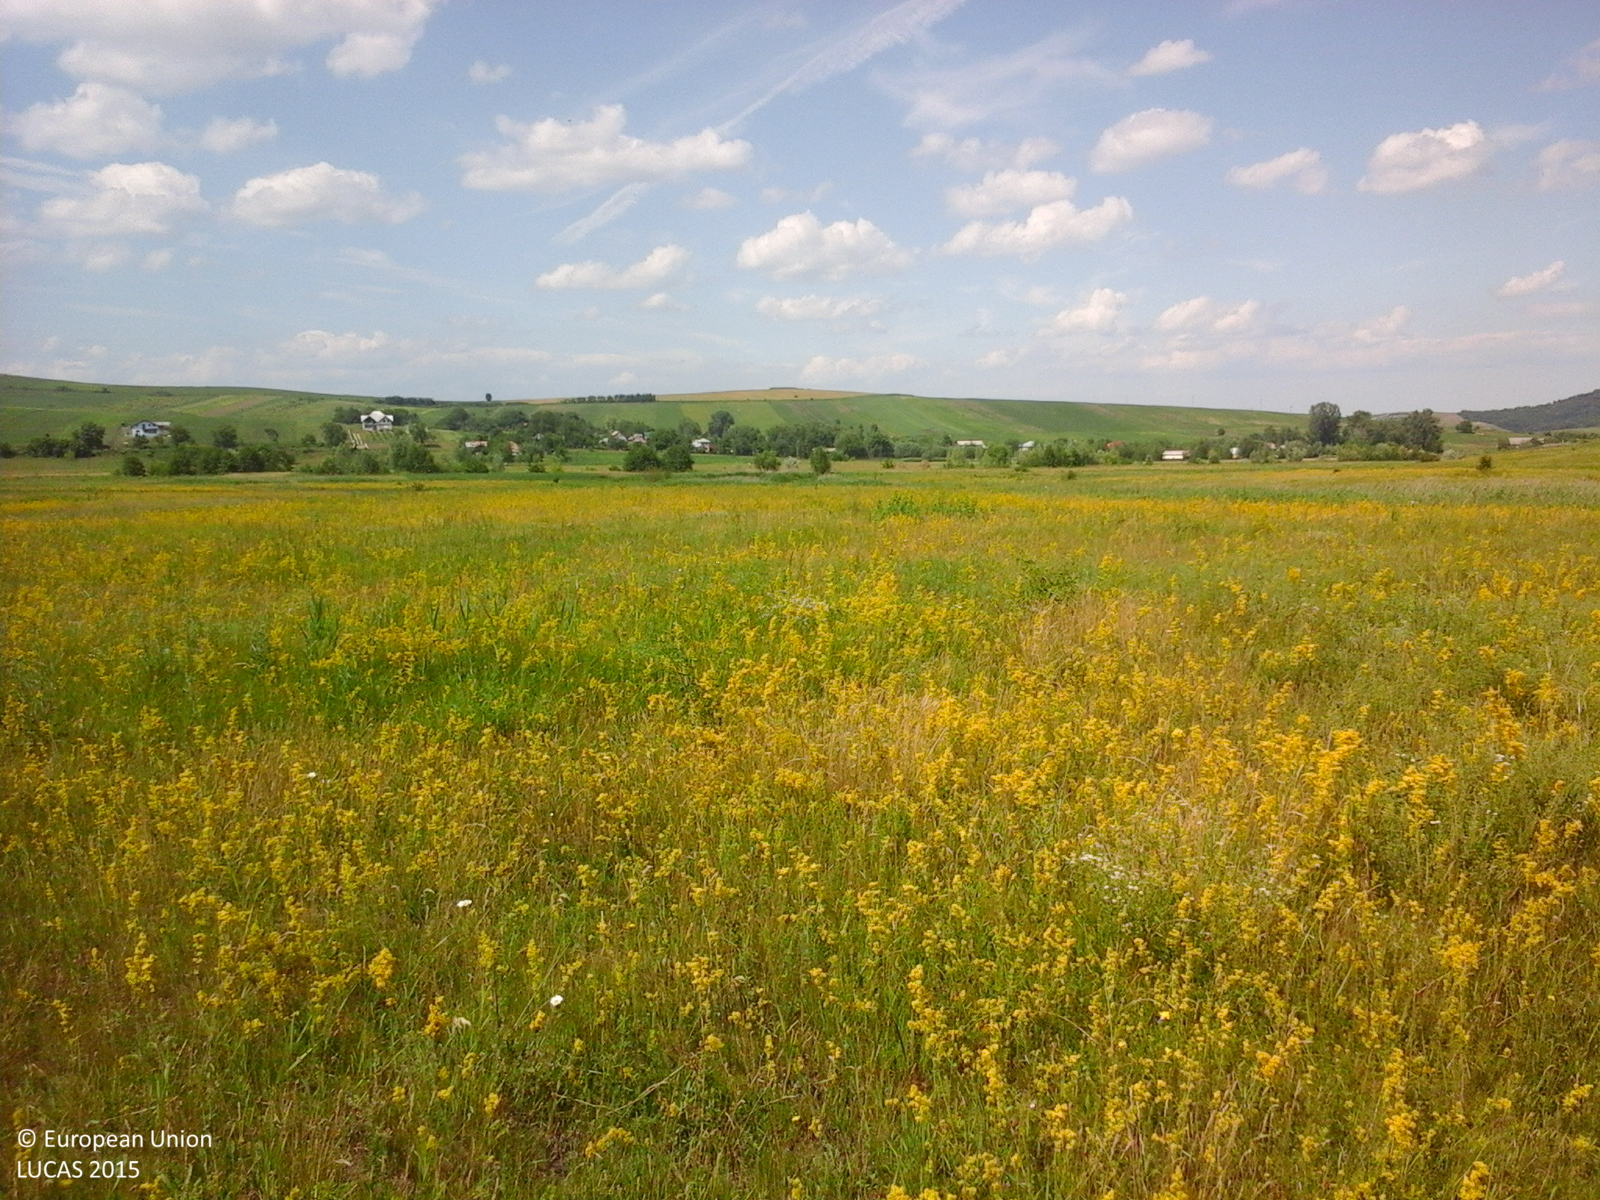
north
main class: Grassland
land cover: Grassland without tree/shrub cover
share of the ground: > 75 %
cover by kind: herbaceous plants 100 %
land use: Agriculture (excluding fallow land and kitchen gardens)
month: June
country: RO
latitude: 47.9068
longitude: 26.3696
